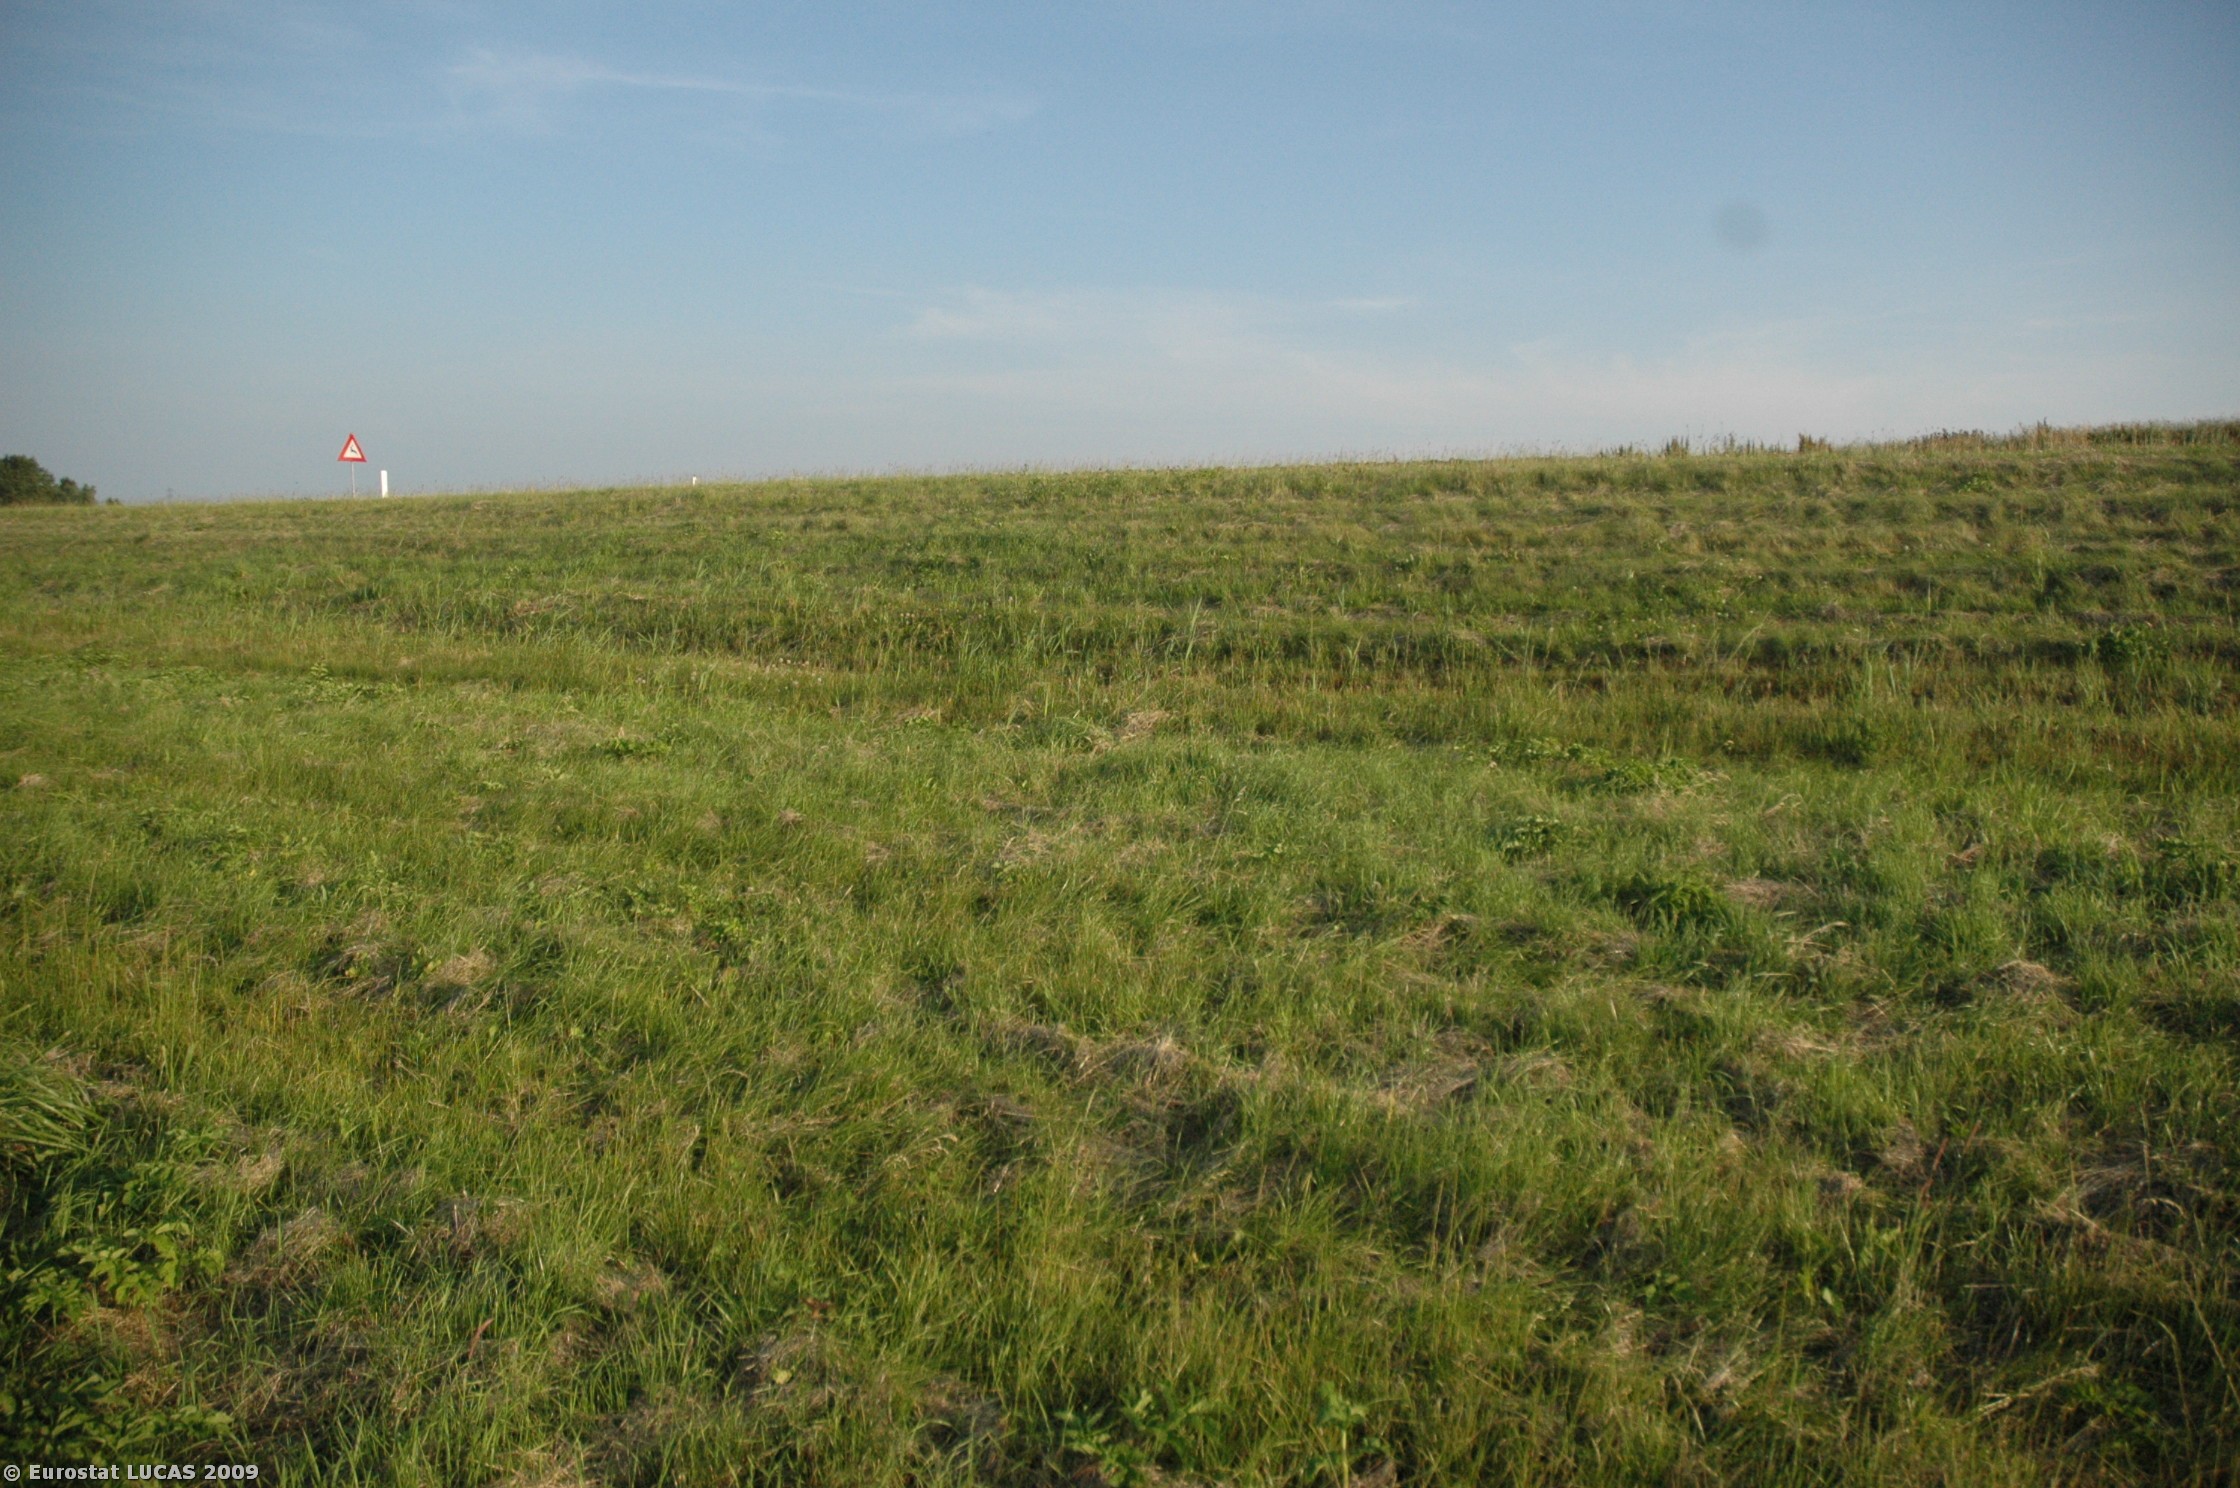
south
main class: Cropland
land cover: Maize
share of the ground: > 75 %
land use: Agriculture (excluding fallow land and kitchen gardens)
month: June
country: NL
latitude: 52.2697
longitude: 5.3821
